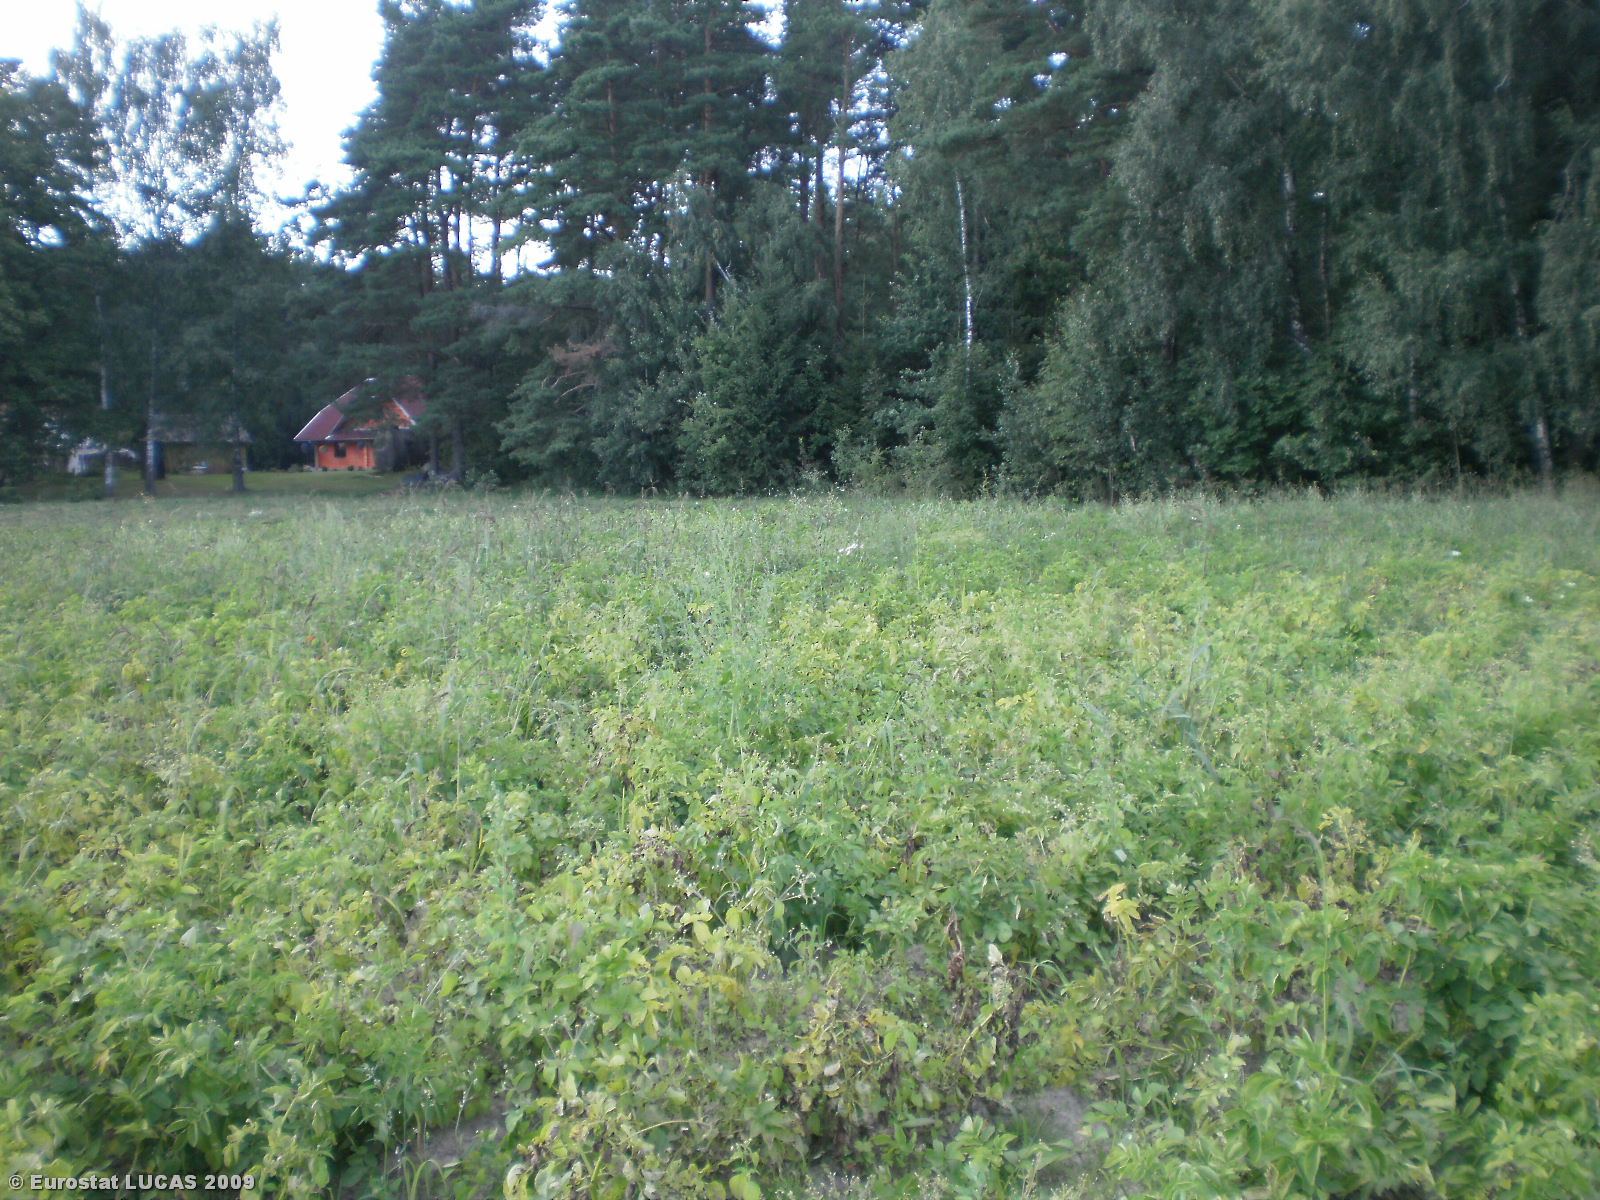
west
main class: Cropland
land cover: Potatoes
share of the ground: > 75 %
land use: Kitchen garden
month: August
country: LT
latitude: 55.3804
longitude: 24.9306
